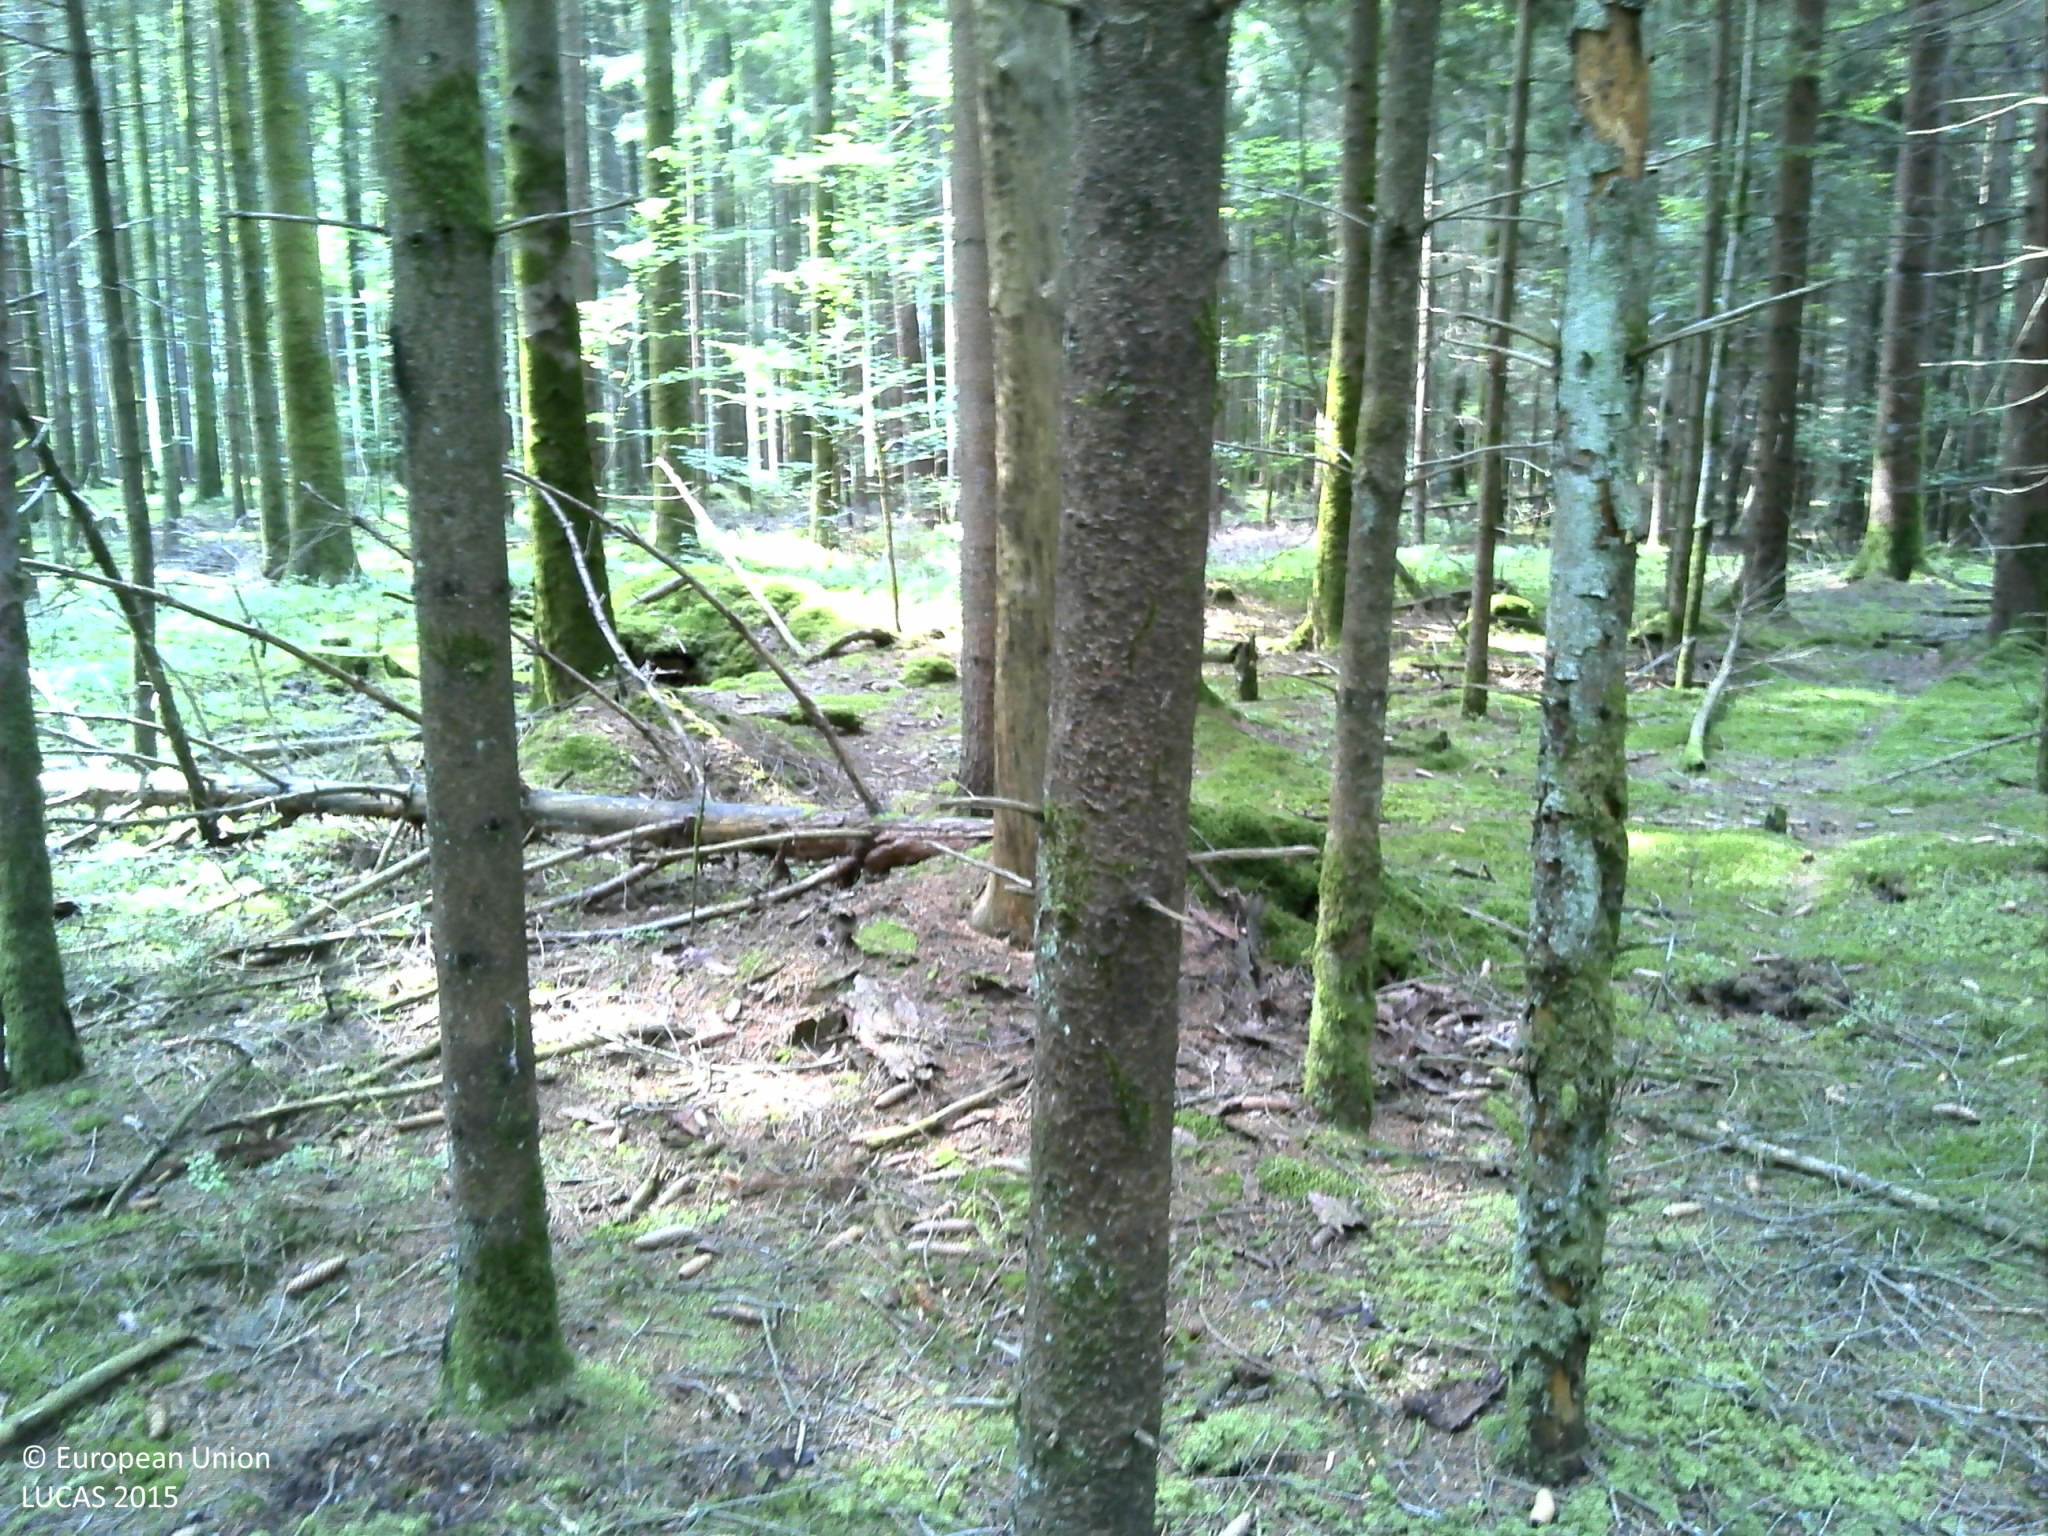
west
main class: Woodland
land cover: Spruce dominated coniferous woodland
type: exotic forest
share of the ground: > 75 %
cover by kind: coniferous forest trees 95 %, lichens and mosses 5 %
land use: Forestry
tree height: > 5 m
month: August
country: FR
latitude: 48.3393
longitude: 6.8034
